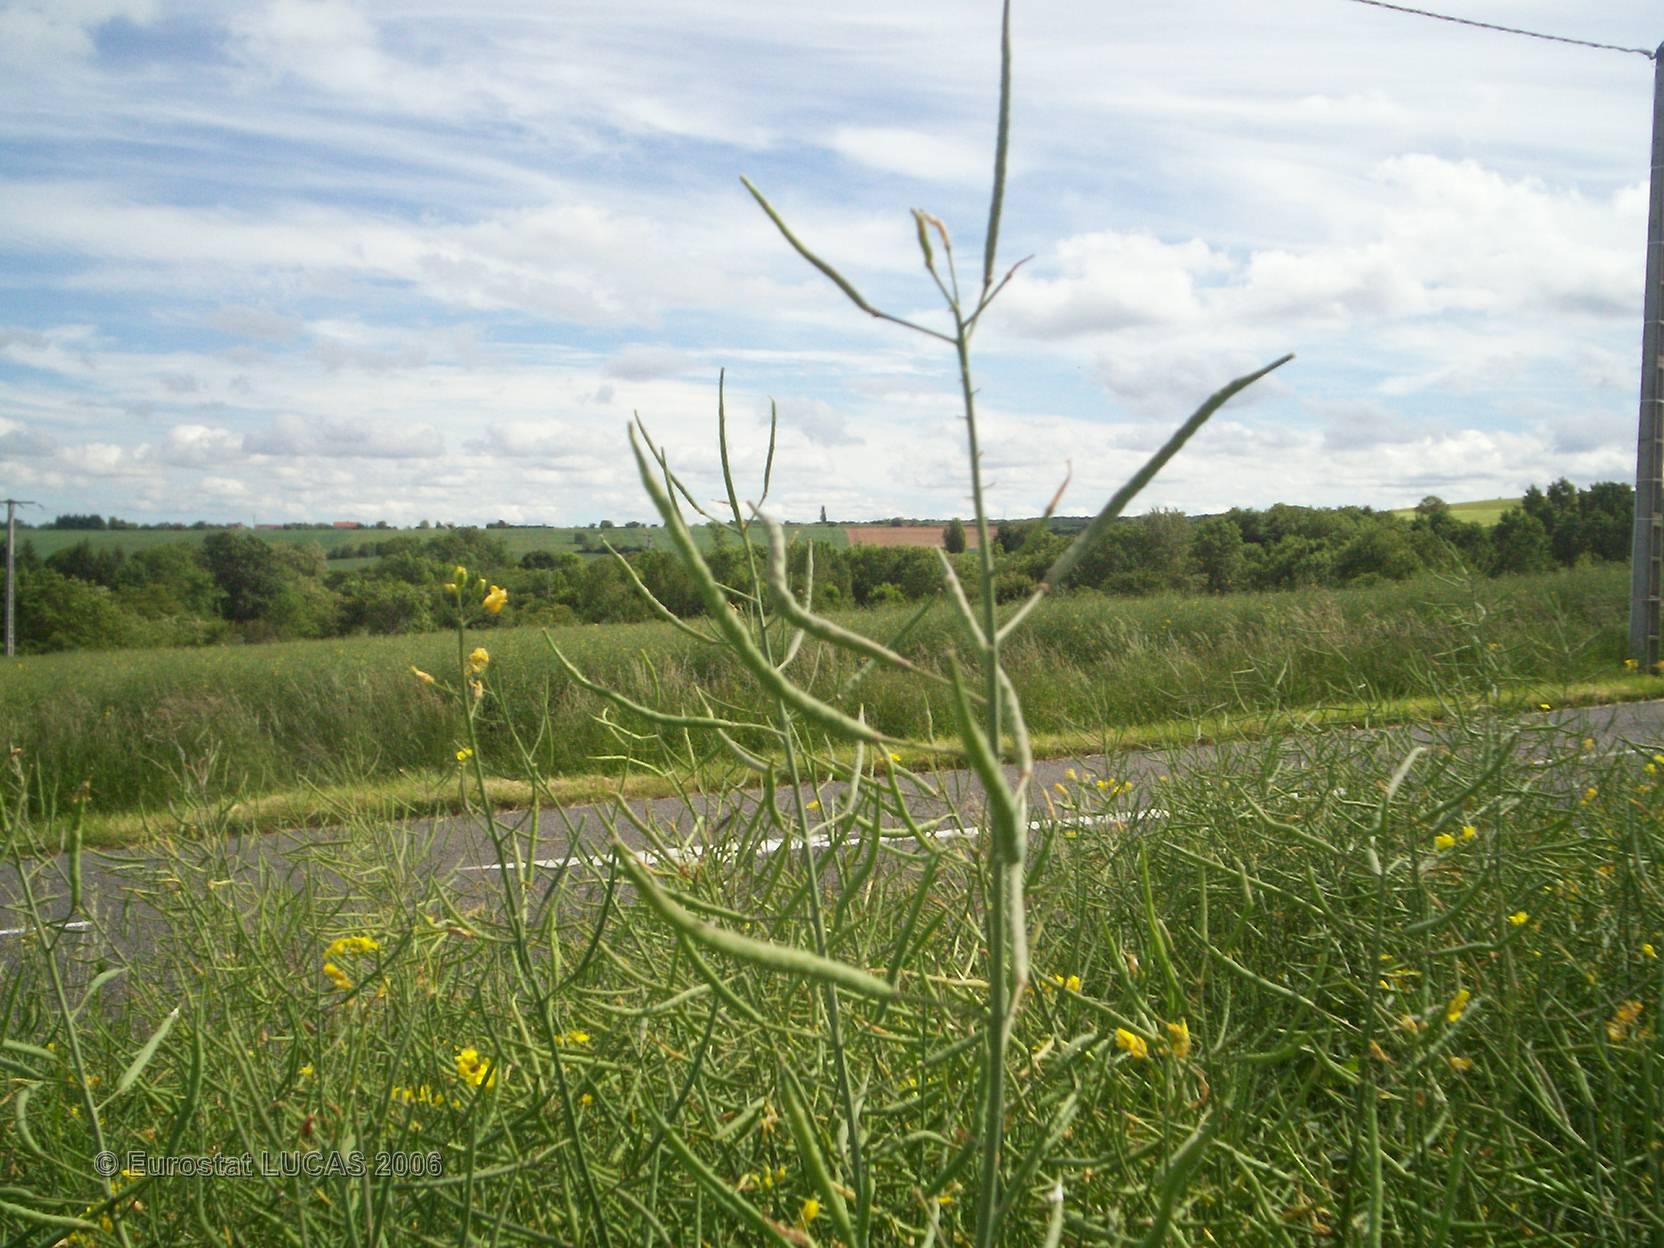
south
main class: Cropland
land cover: Rape and turnip rape
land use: Agriculture (excluding fallow land and kitchen gardens)
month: May
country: FR
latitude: 46.1983
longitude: 3.0653
